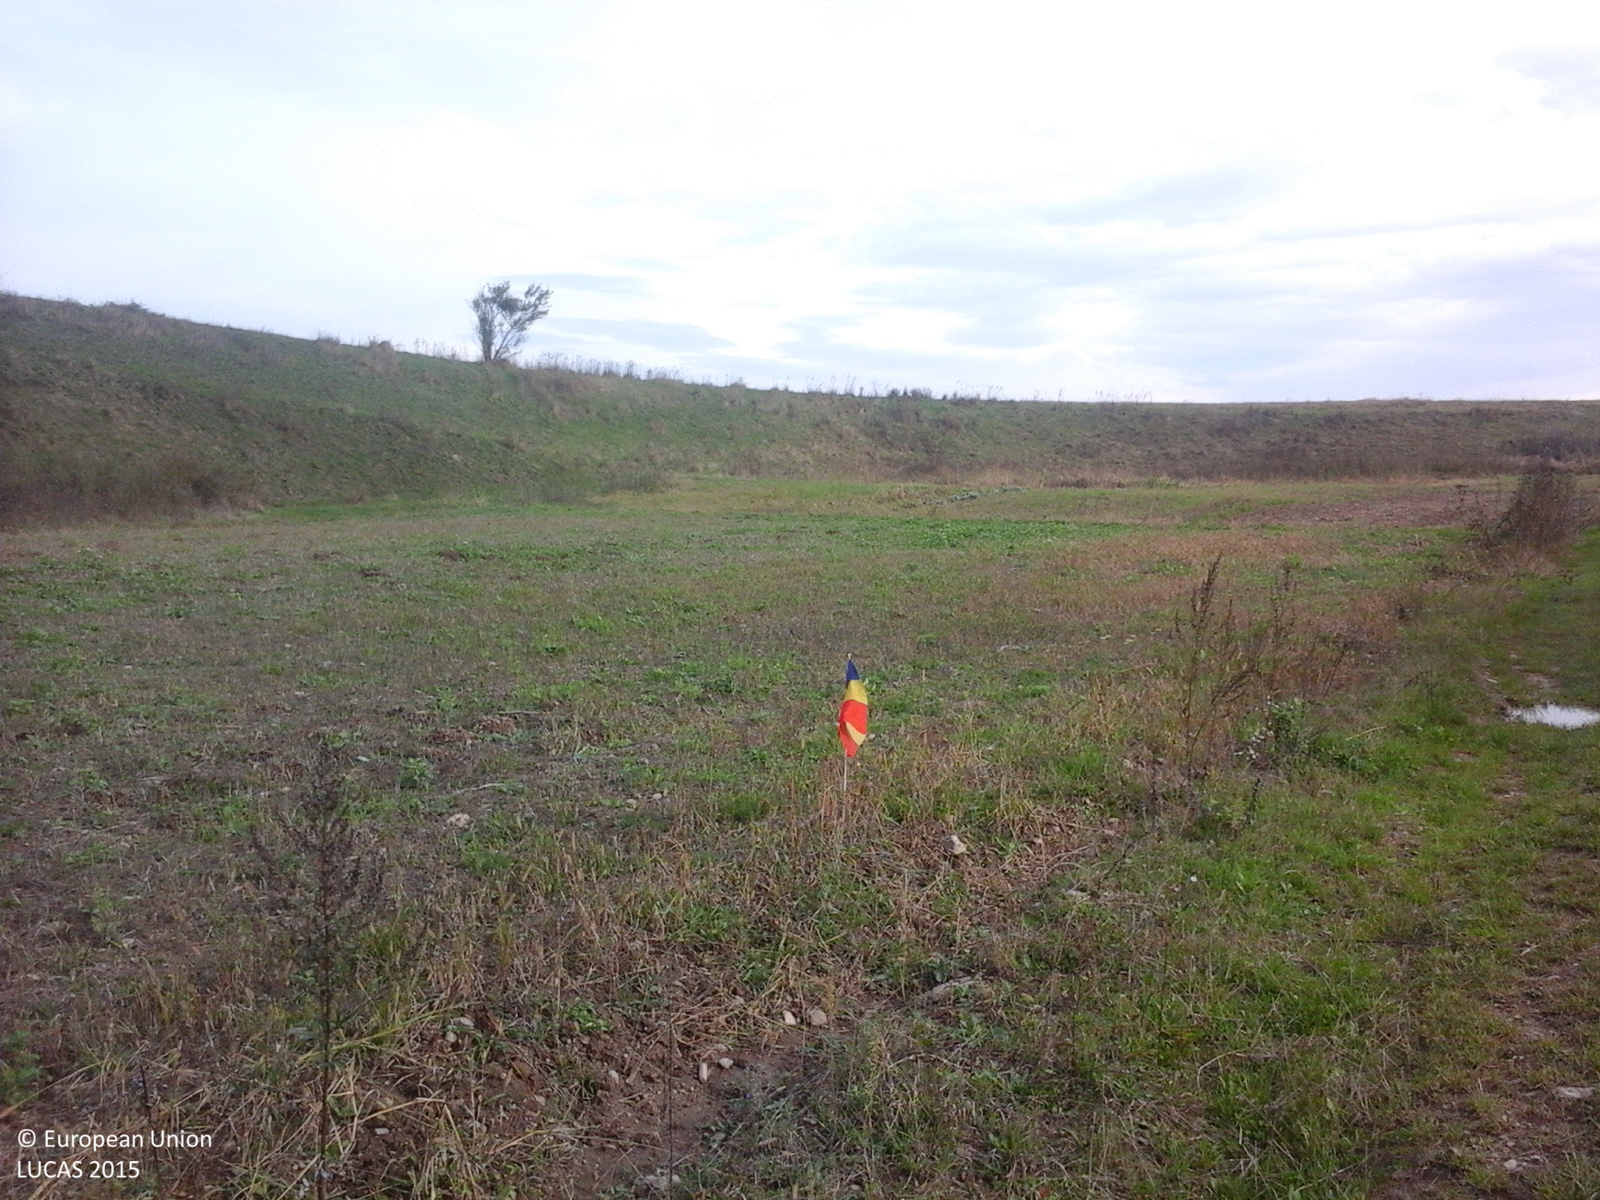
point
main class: Grassland
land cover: Grassland without tree/shrub cover
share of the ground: > 75 %
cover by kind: herbaceous plants 100 %
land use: Agriculture (excluding fallow land and kitchen gardens)
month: October
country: RO
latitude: 45.7908
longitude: 25.0542
